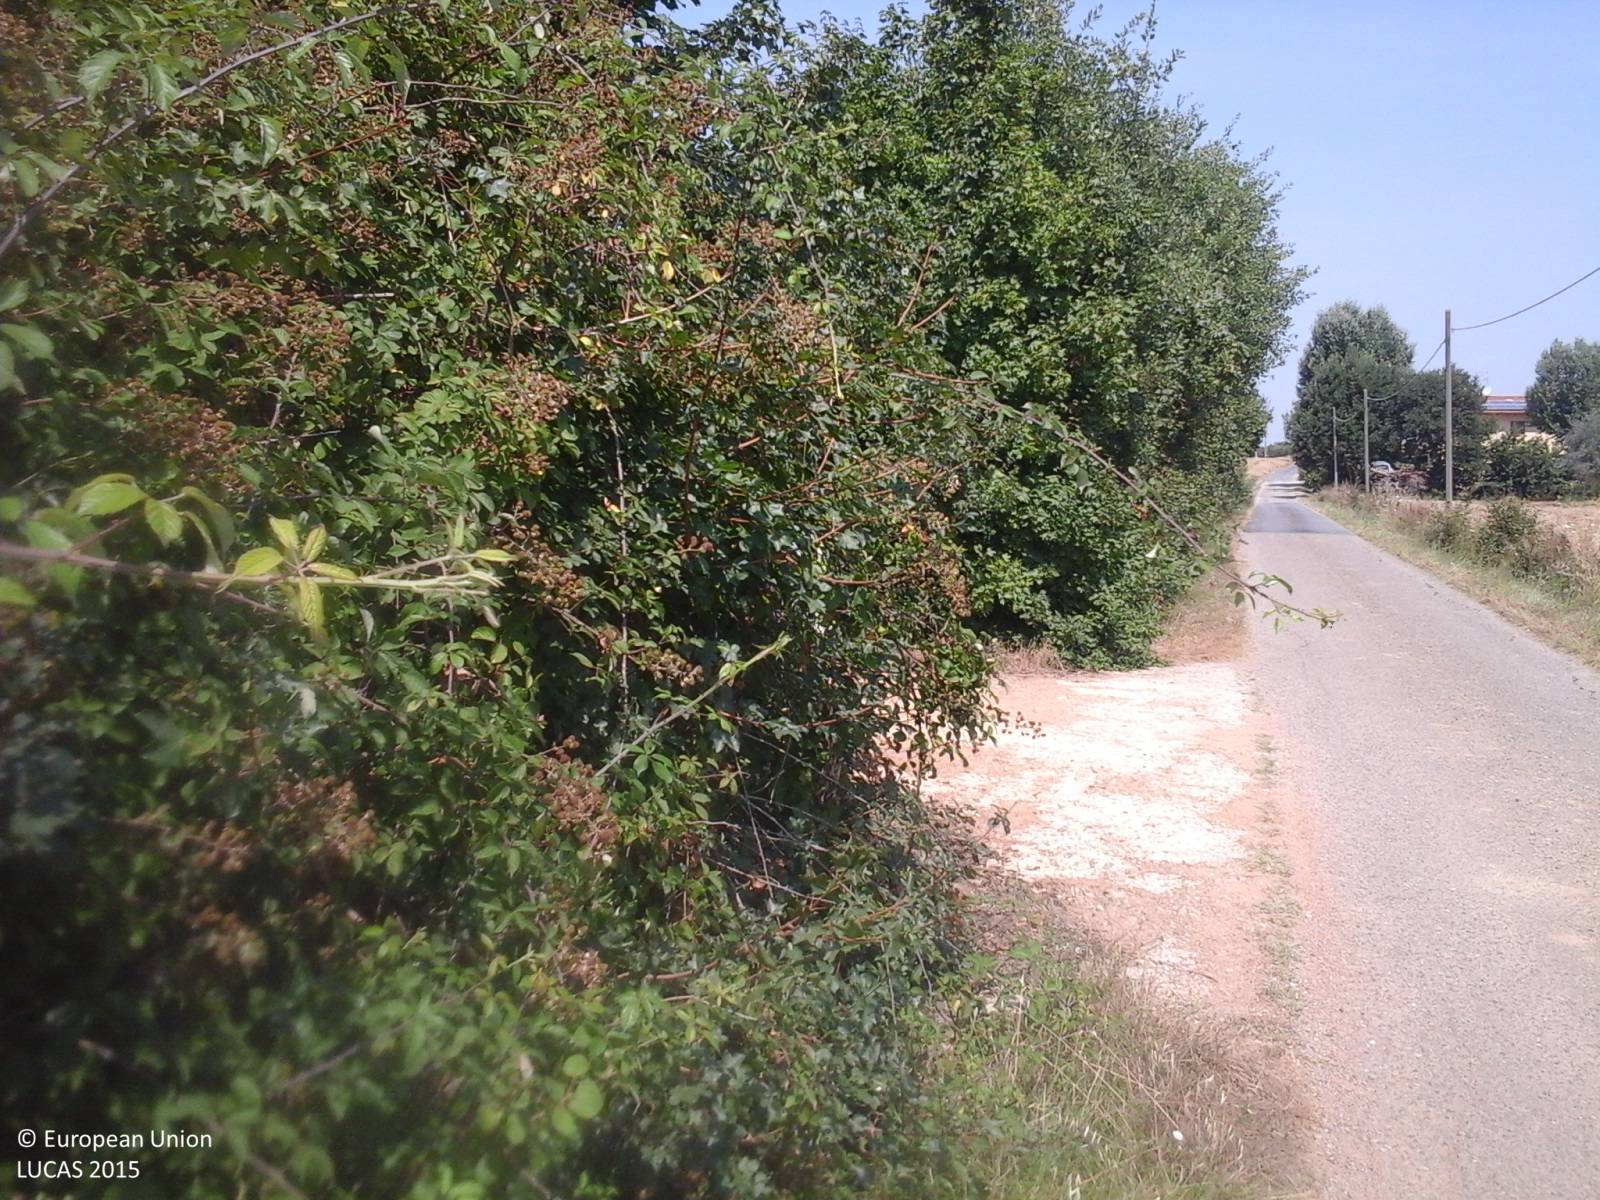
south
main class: Shrubland
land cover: Shrubland with sparse tree cover
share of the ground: 50 - 75 %
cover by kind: shrubs 95 %, broadleaved forest trees 5 %
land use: Abandoned areas
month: July
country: IT
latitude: 43.3048
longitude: 11.8808
